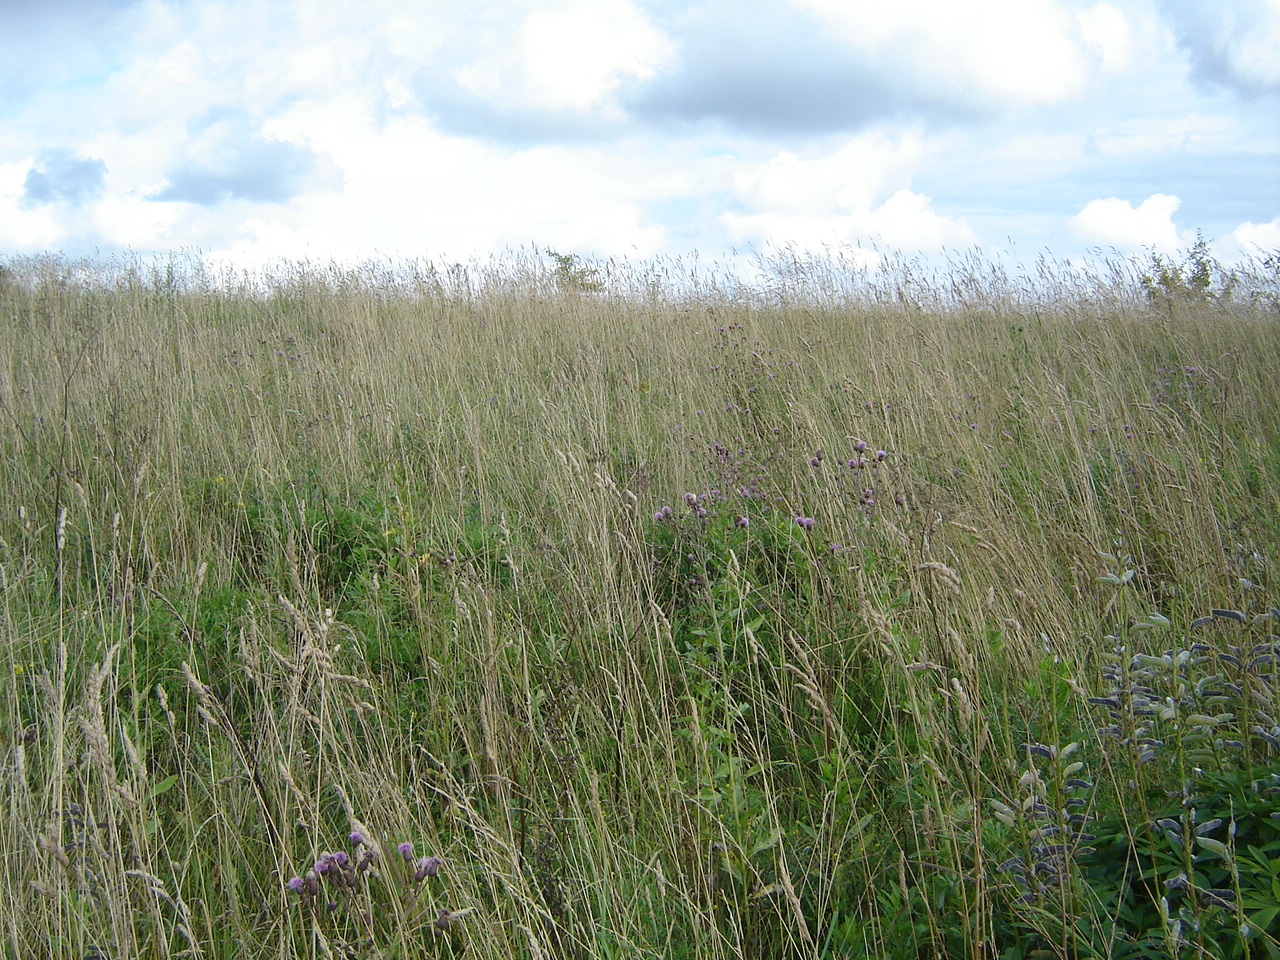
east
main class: Grassland
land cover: Spontaneously vegetated surfaces
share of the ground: > 75 %
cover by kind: herbaceous plants 100 %
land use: Fallow land
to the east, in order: Spontaneously vegetated surfaces; Electric lines; Spontaneously vegetated surfaces; Grassland with sparse tree/shrub cover; Inland marshes
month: July
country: LT
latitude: 55.2767
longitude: 25.1818
